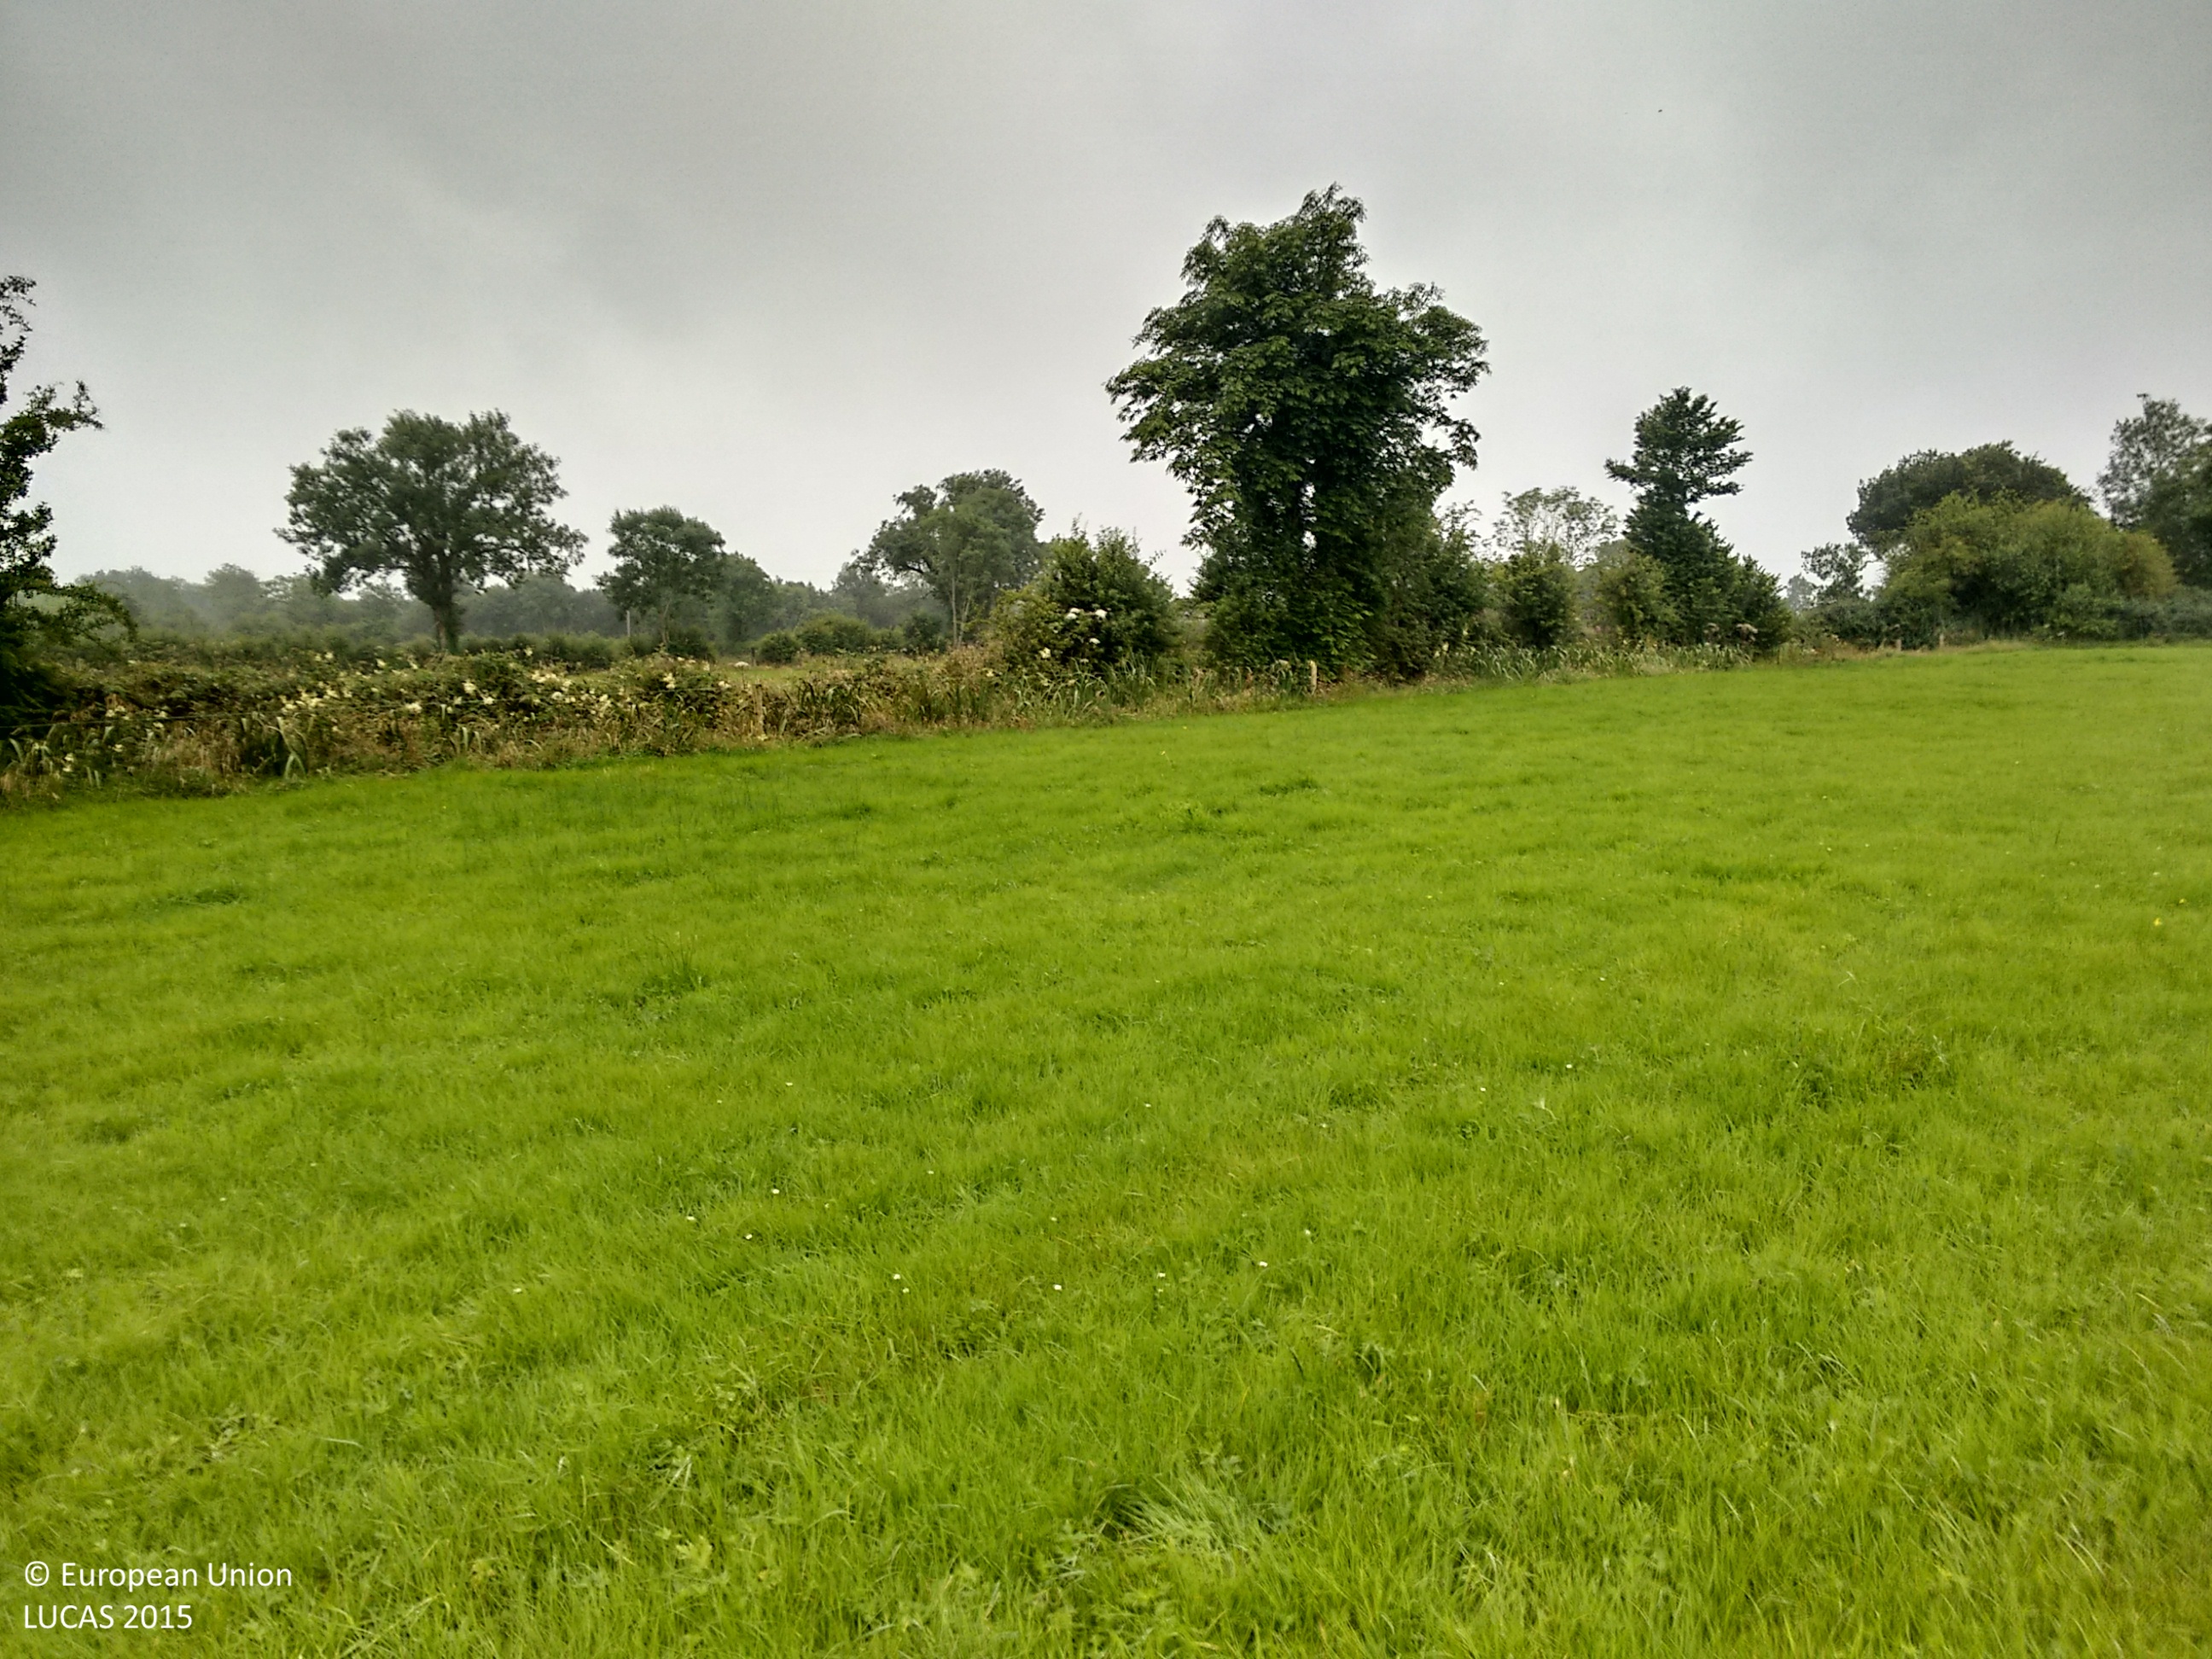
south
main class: Grassland
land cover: Grassland without tree/shrub cover
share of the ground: > 75 %
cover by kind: herbaceous plants 100 %
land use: Agriculture (excluding fallow land and kitchen gardens)
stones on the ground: < 10 %
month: July
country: IE
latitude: 53.7801
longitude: -7.8176
